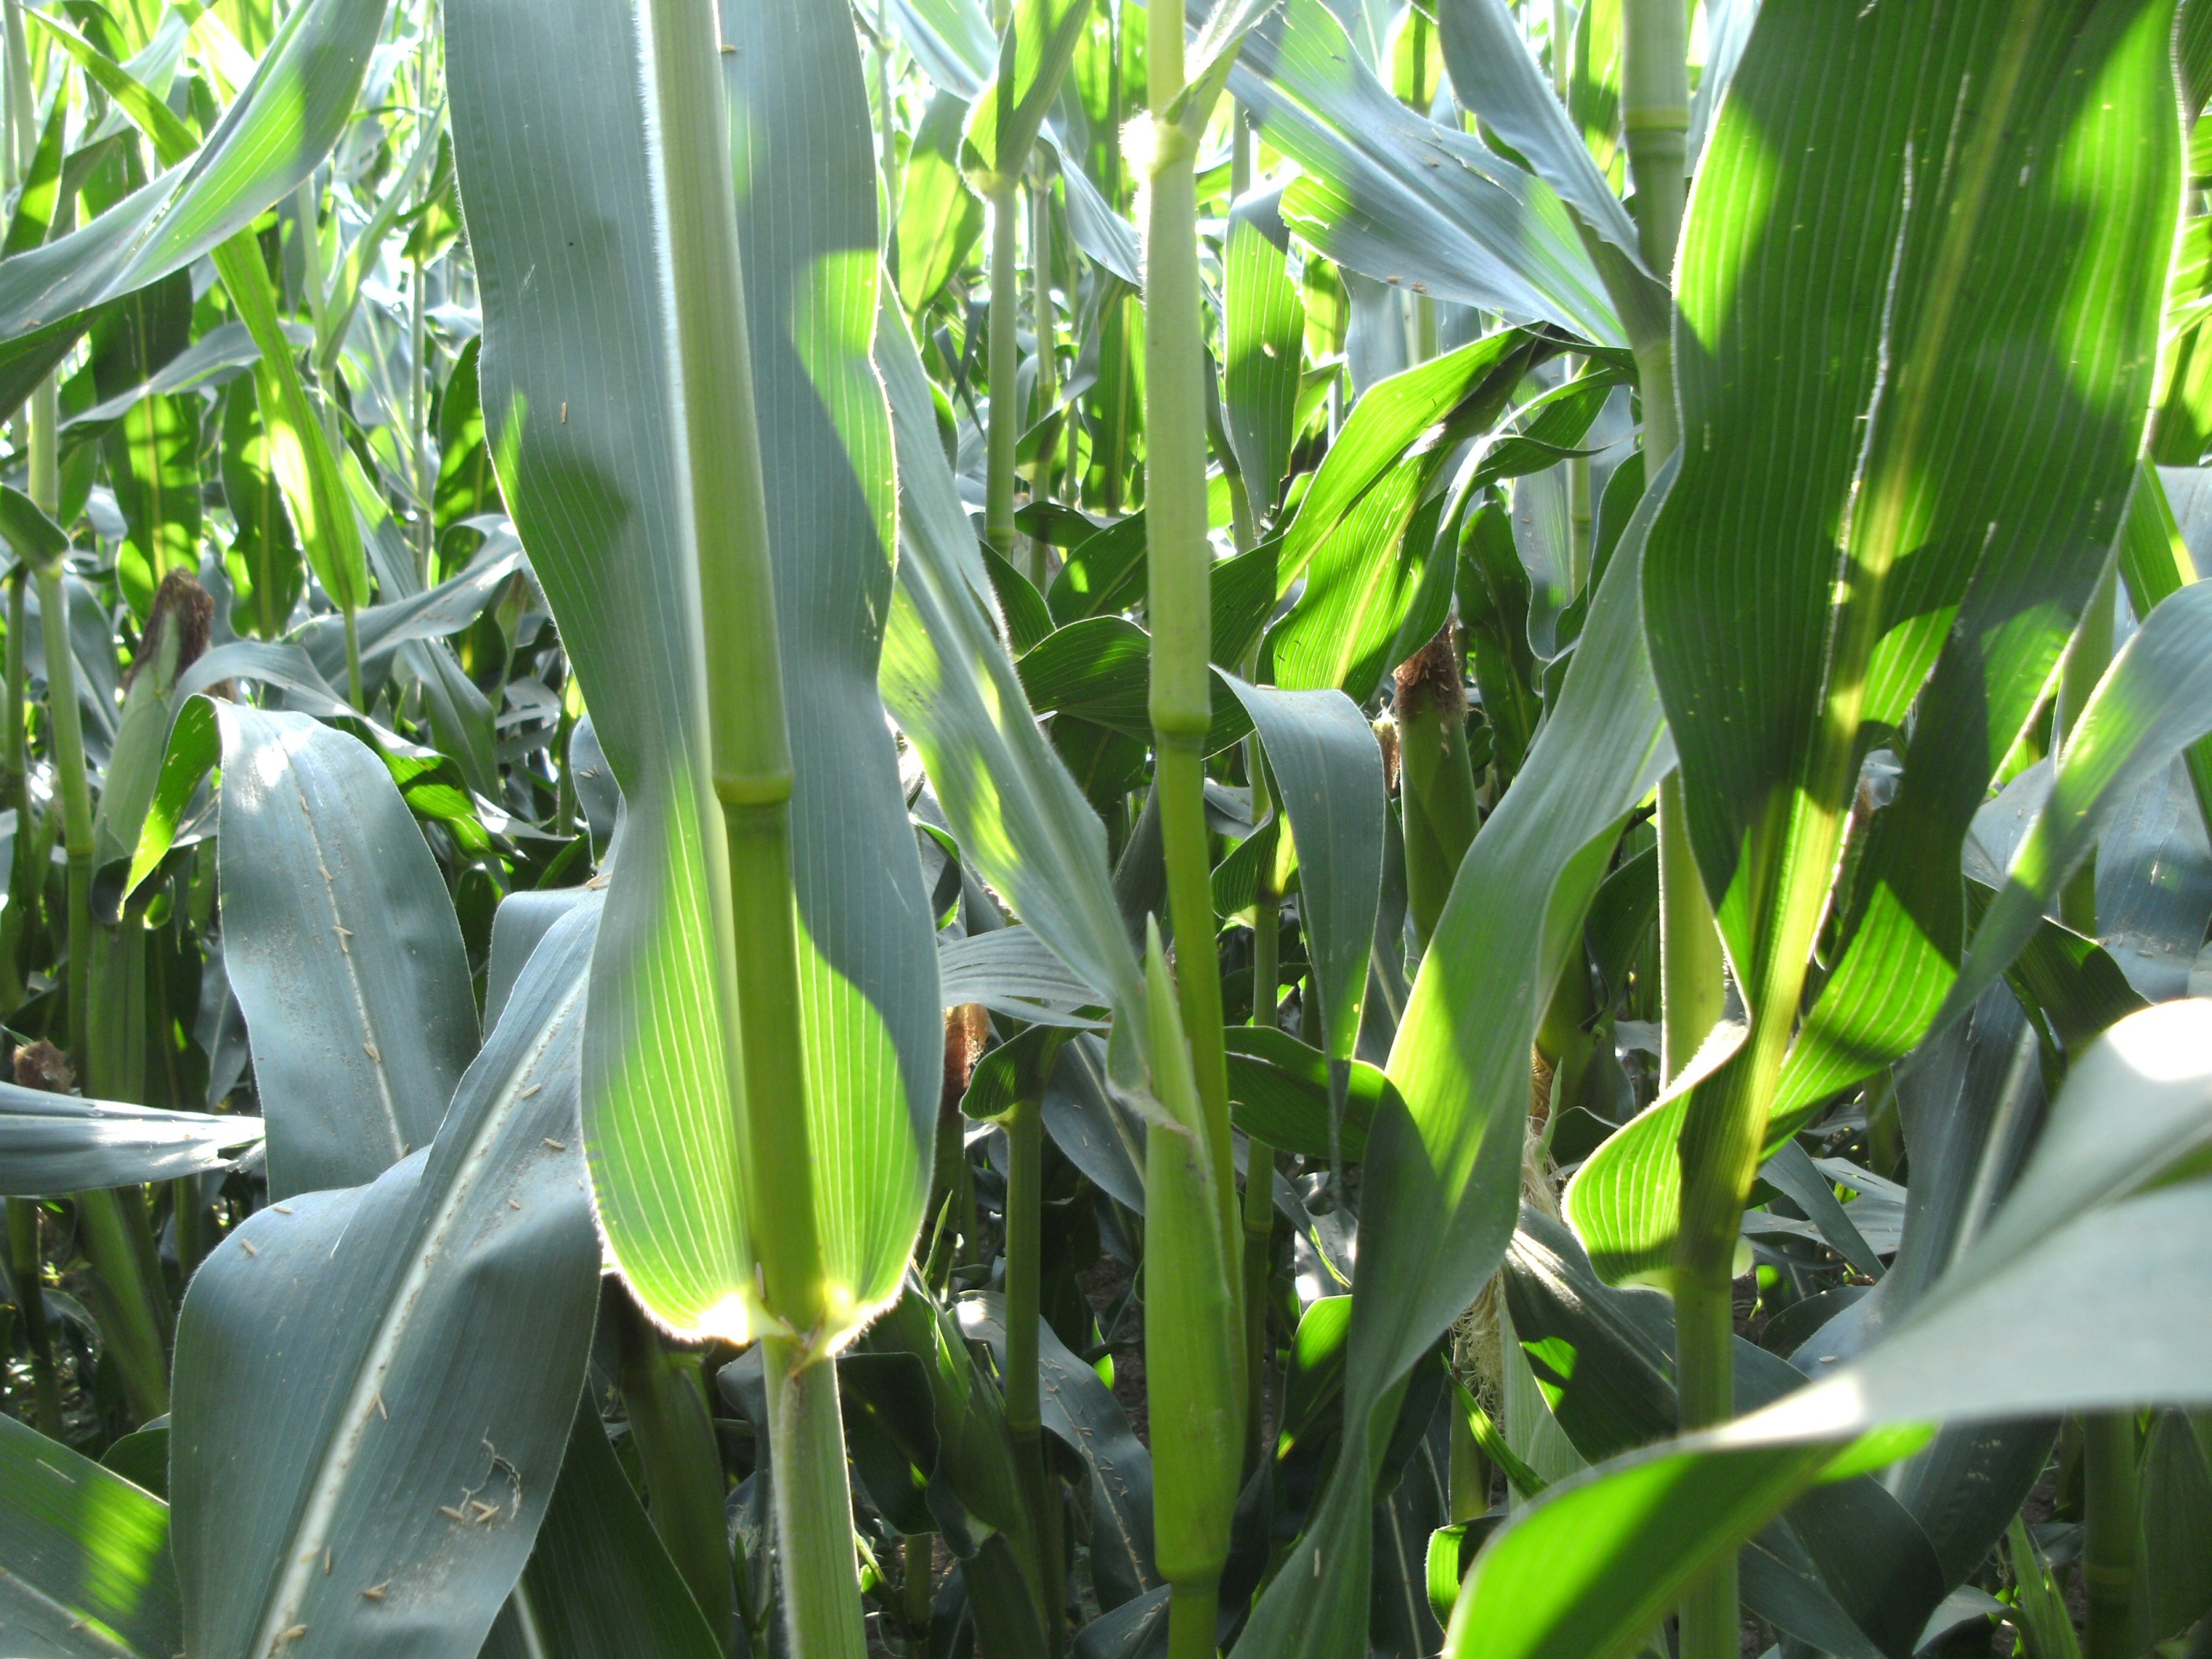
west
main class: Cropland
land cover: Maize
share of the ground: > 75 %
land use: Agriculture (excluding fallow land and kitchen gardens)
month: July
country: AT
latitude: 46.5497
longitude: 14.8103
